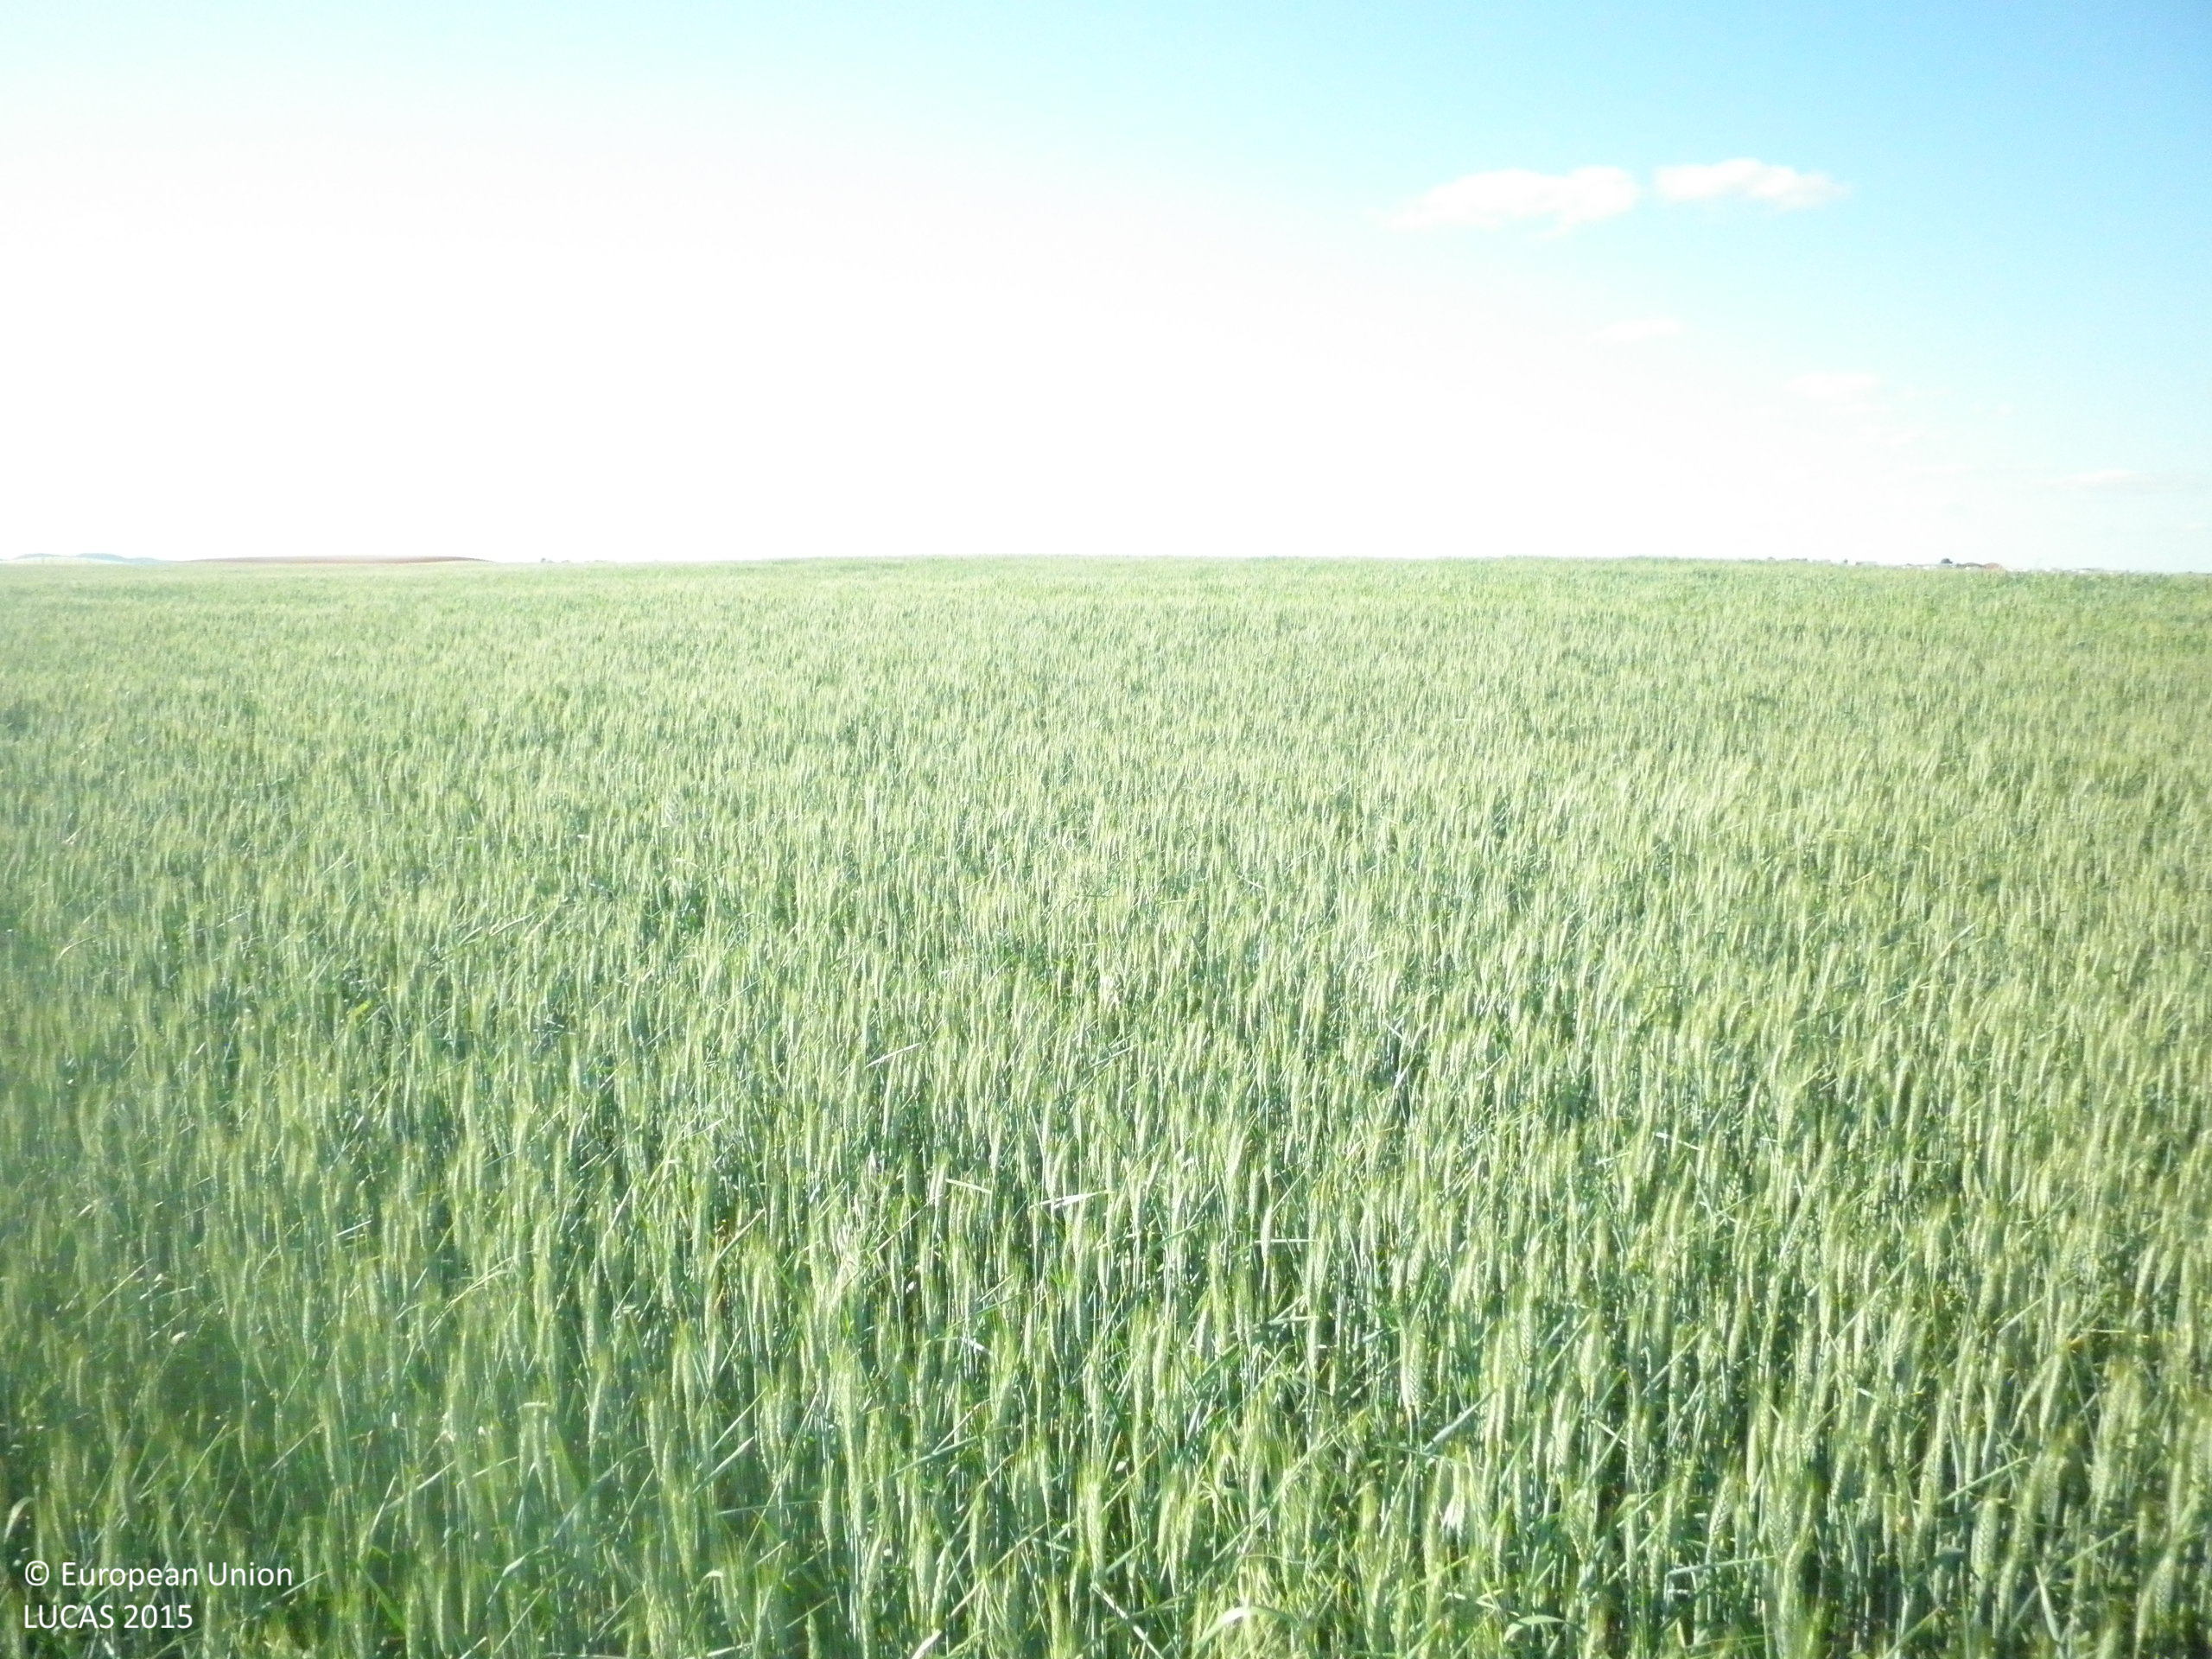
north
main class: Cropland
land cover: Rye
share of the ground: > 75 %
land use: Agriculture (excluding fallow land and kitchen gardens)
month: May
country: ES
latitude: 39.6864
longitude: -2.7616
